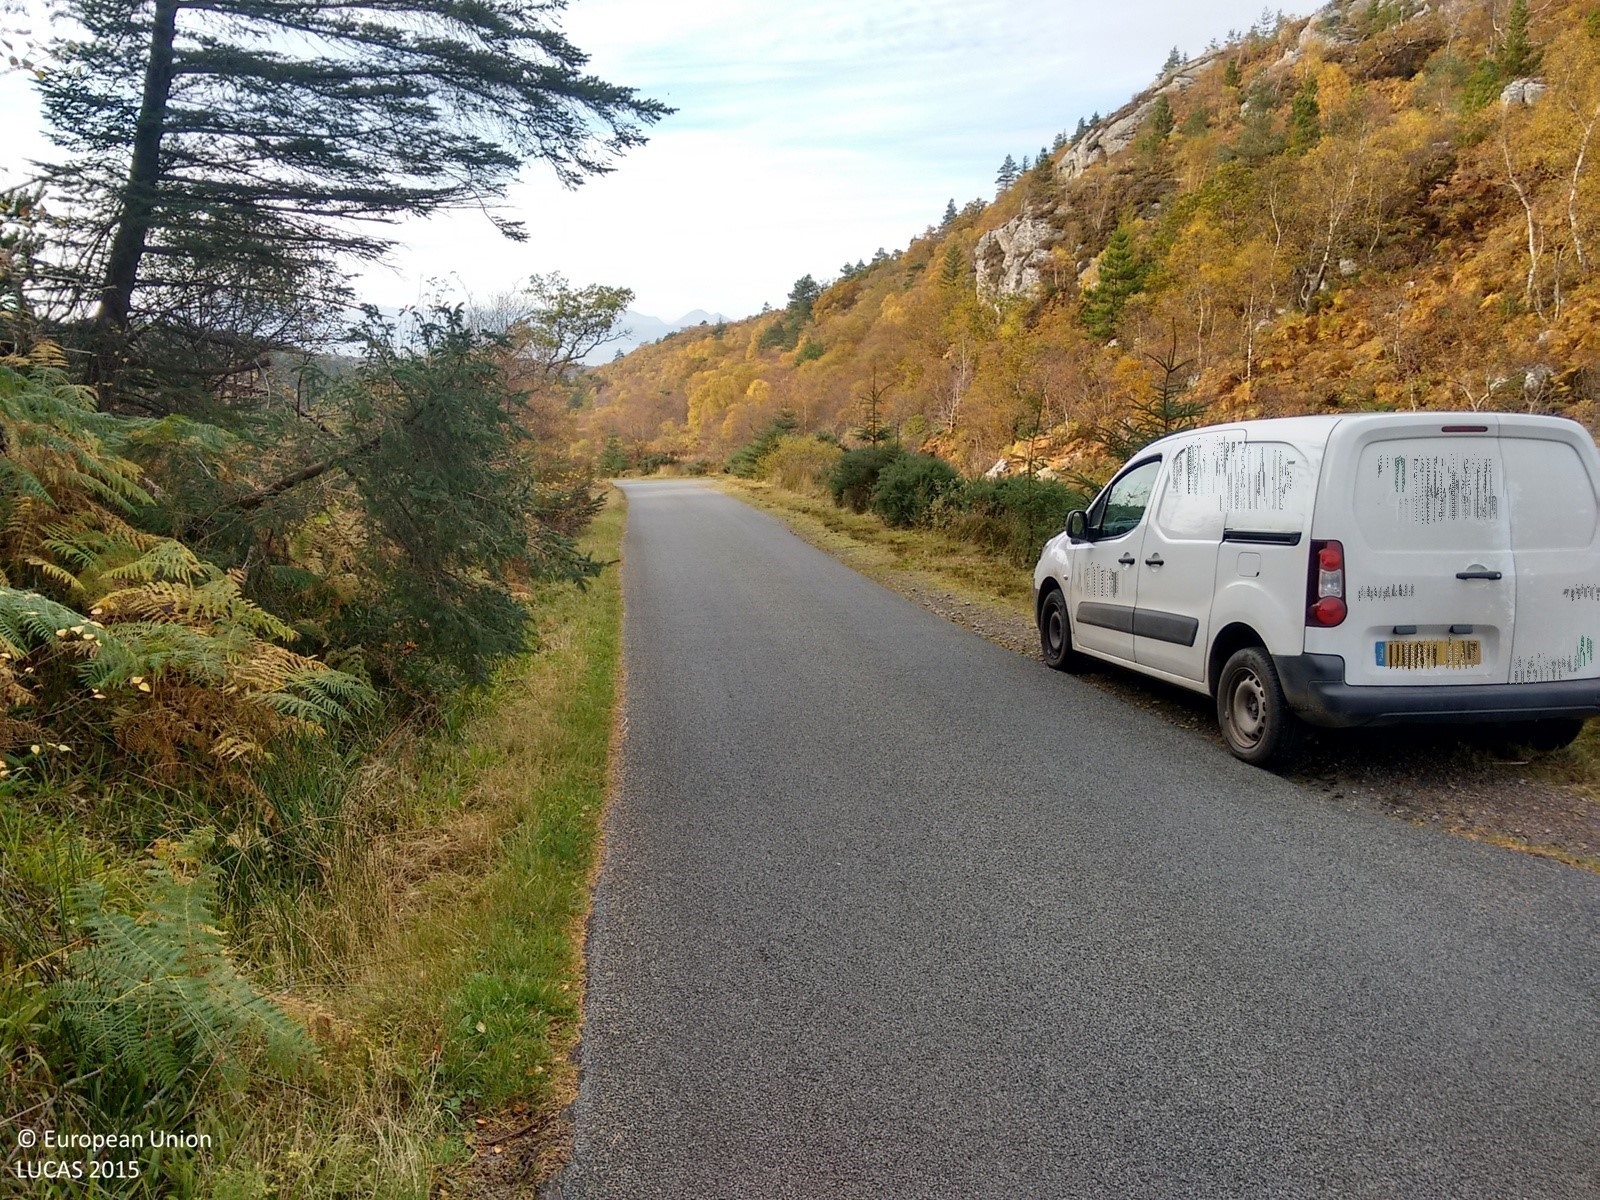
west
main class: Woodland
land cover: Spruce dominated coniferous woodland
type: exotic forest
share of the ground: > 75 %
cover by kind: coniferous forest trees 80 %, shrubs 10 %, herbaceous plants 10 %
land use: Forestry
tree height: > 5 m
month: November
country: GB
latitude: 57.3306
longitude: -5.6506
